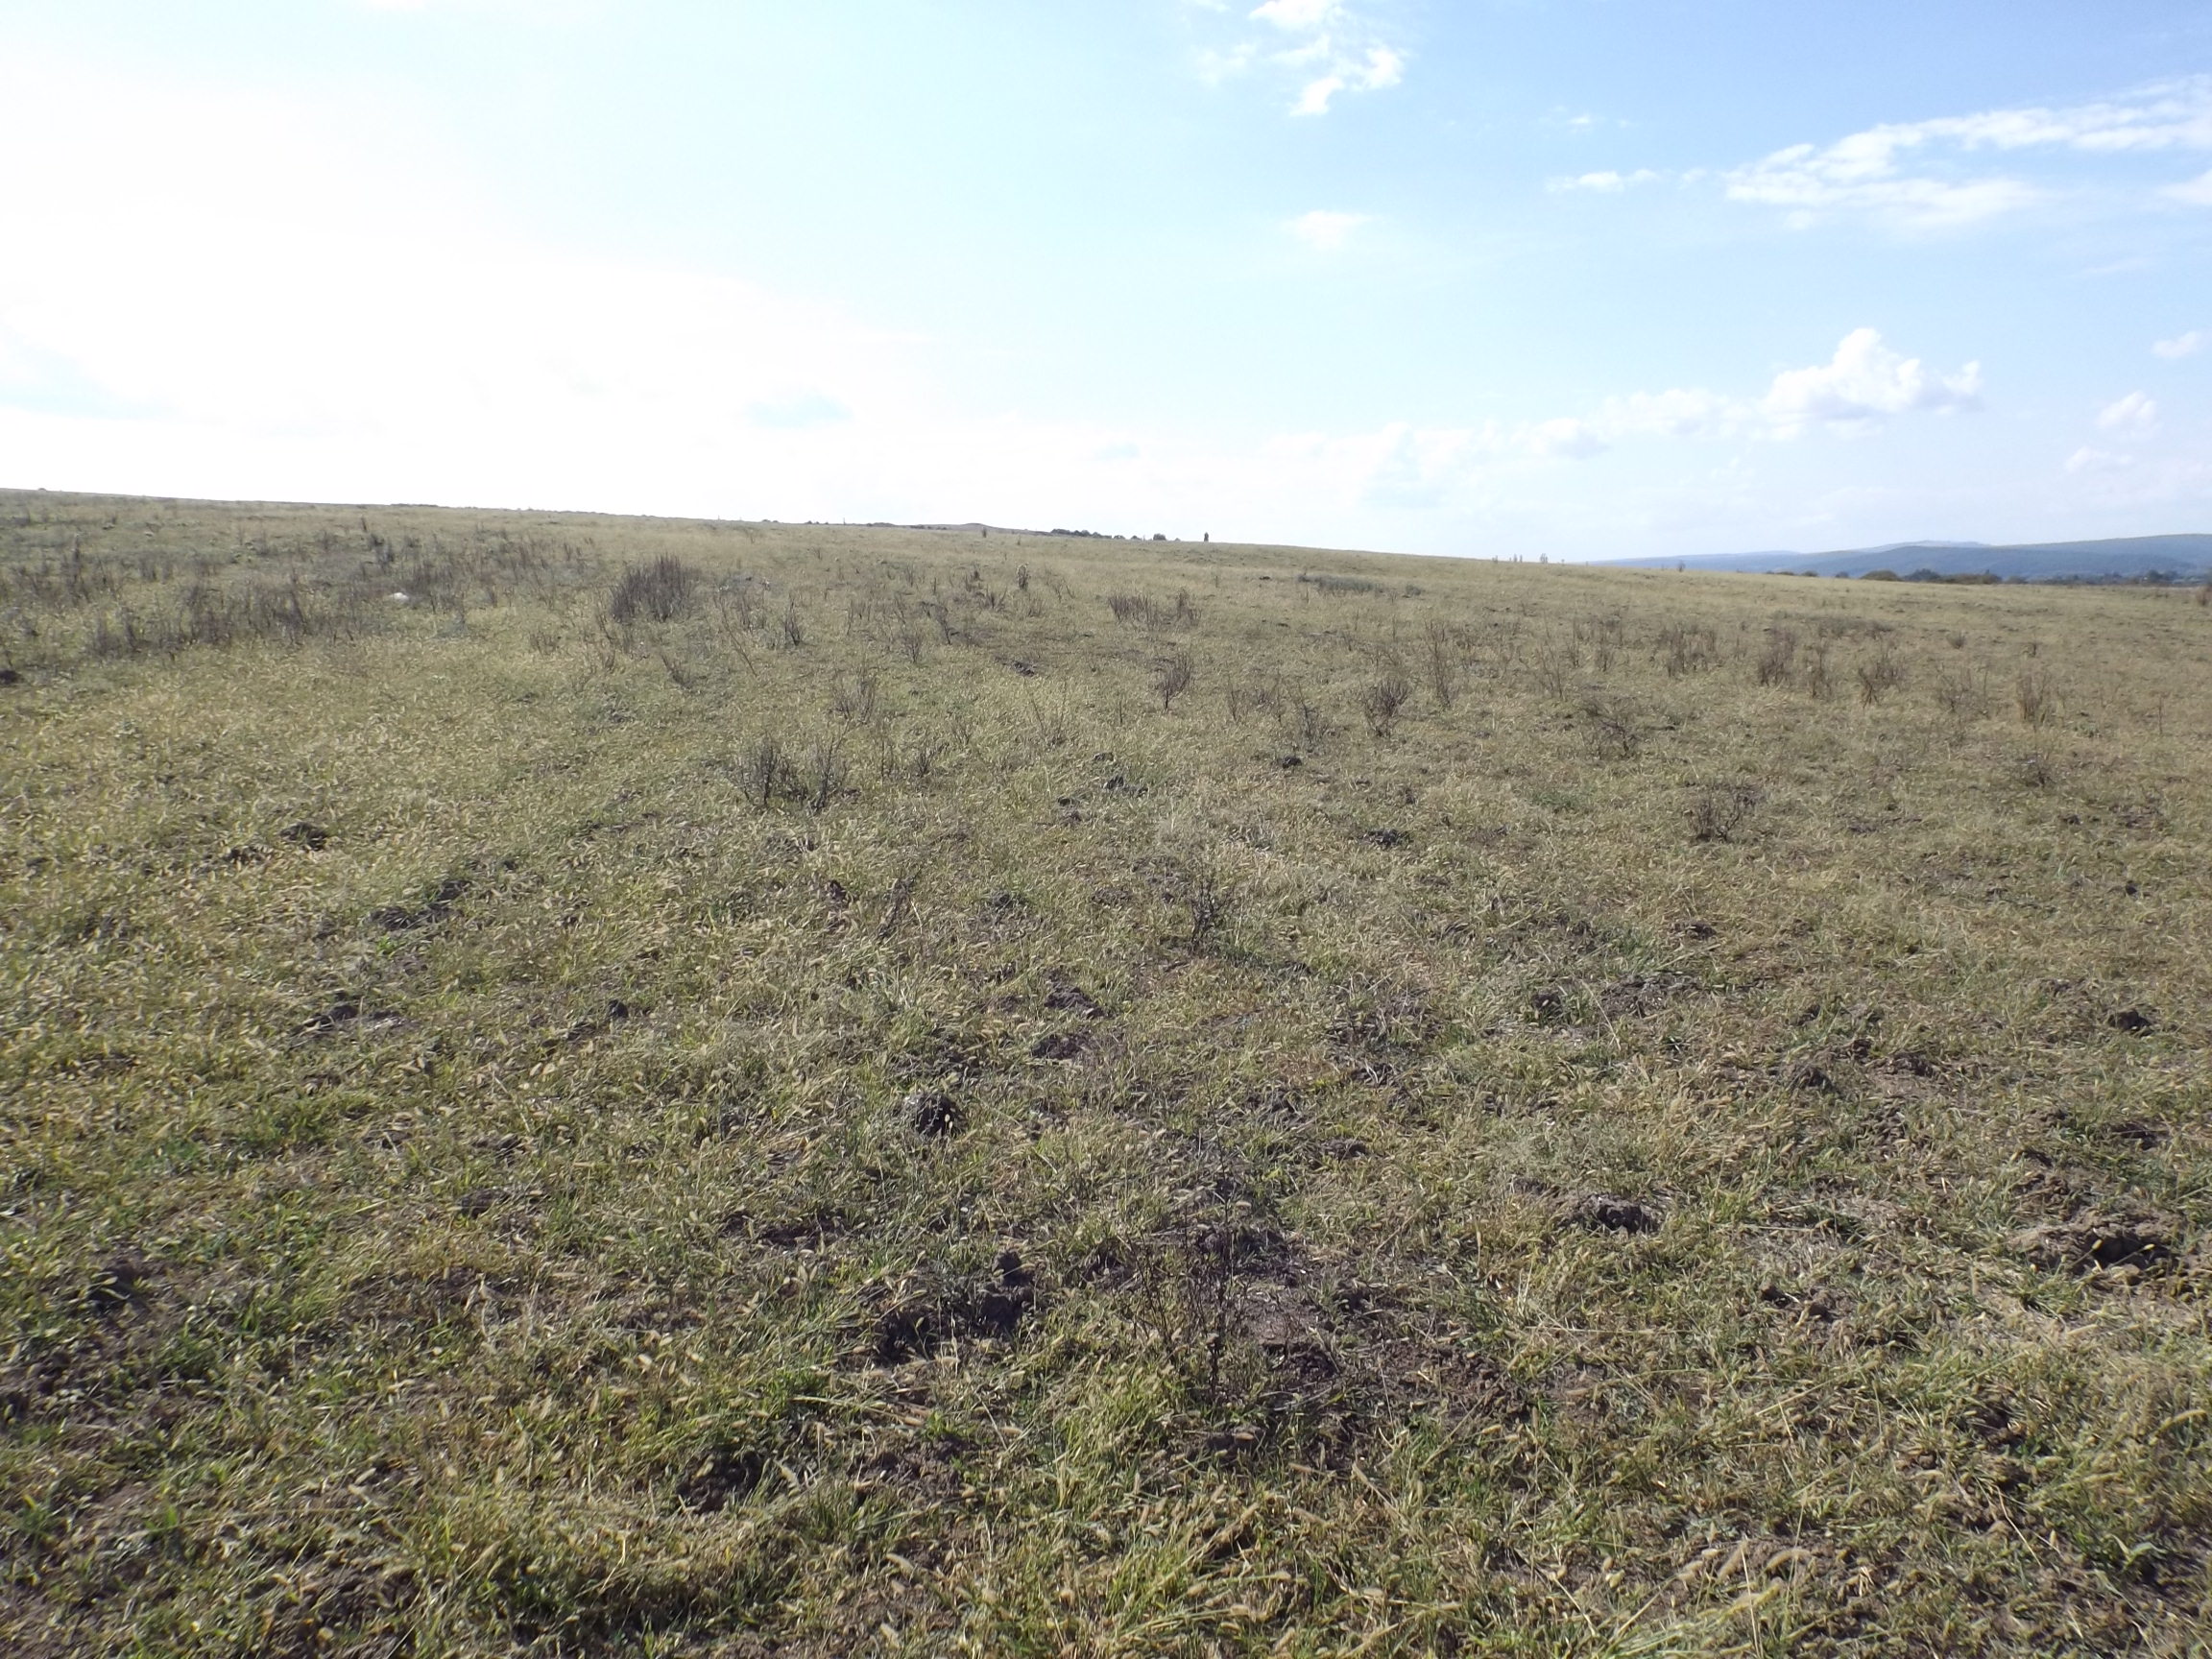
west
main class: Grassland
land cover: Spontaneously vegetated surfaces
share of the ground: 50 - 75 %
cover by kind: herbaceous plants 75 %, unconsolidated bare surface 25 %
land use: Fallow land
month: September
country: BG
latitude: 43.0223
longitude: 27.5640
